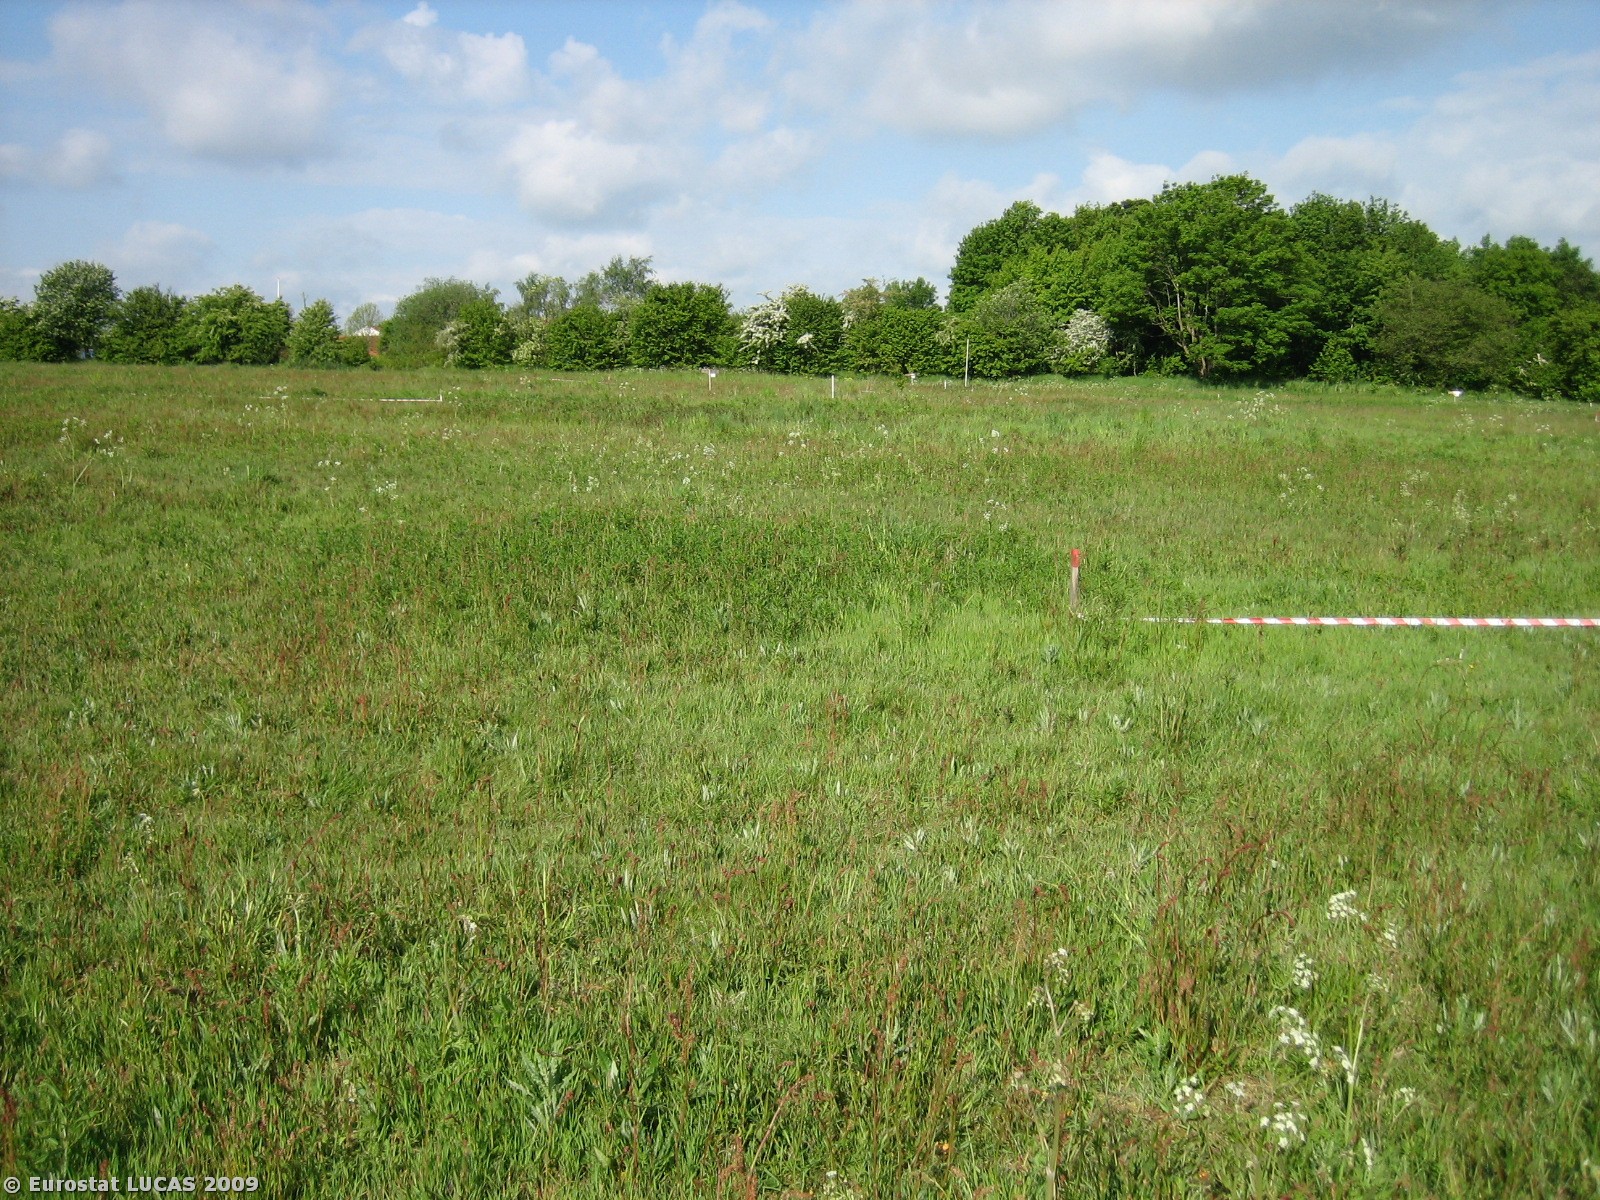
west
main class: Grassland
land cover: Grassland without tree/shrub cover
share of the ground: > 75 %
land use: Construction
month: May
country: DK
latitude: 56.1658
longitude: 8.9866
